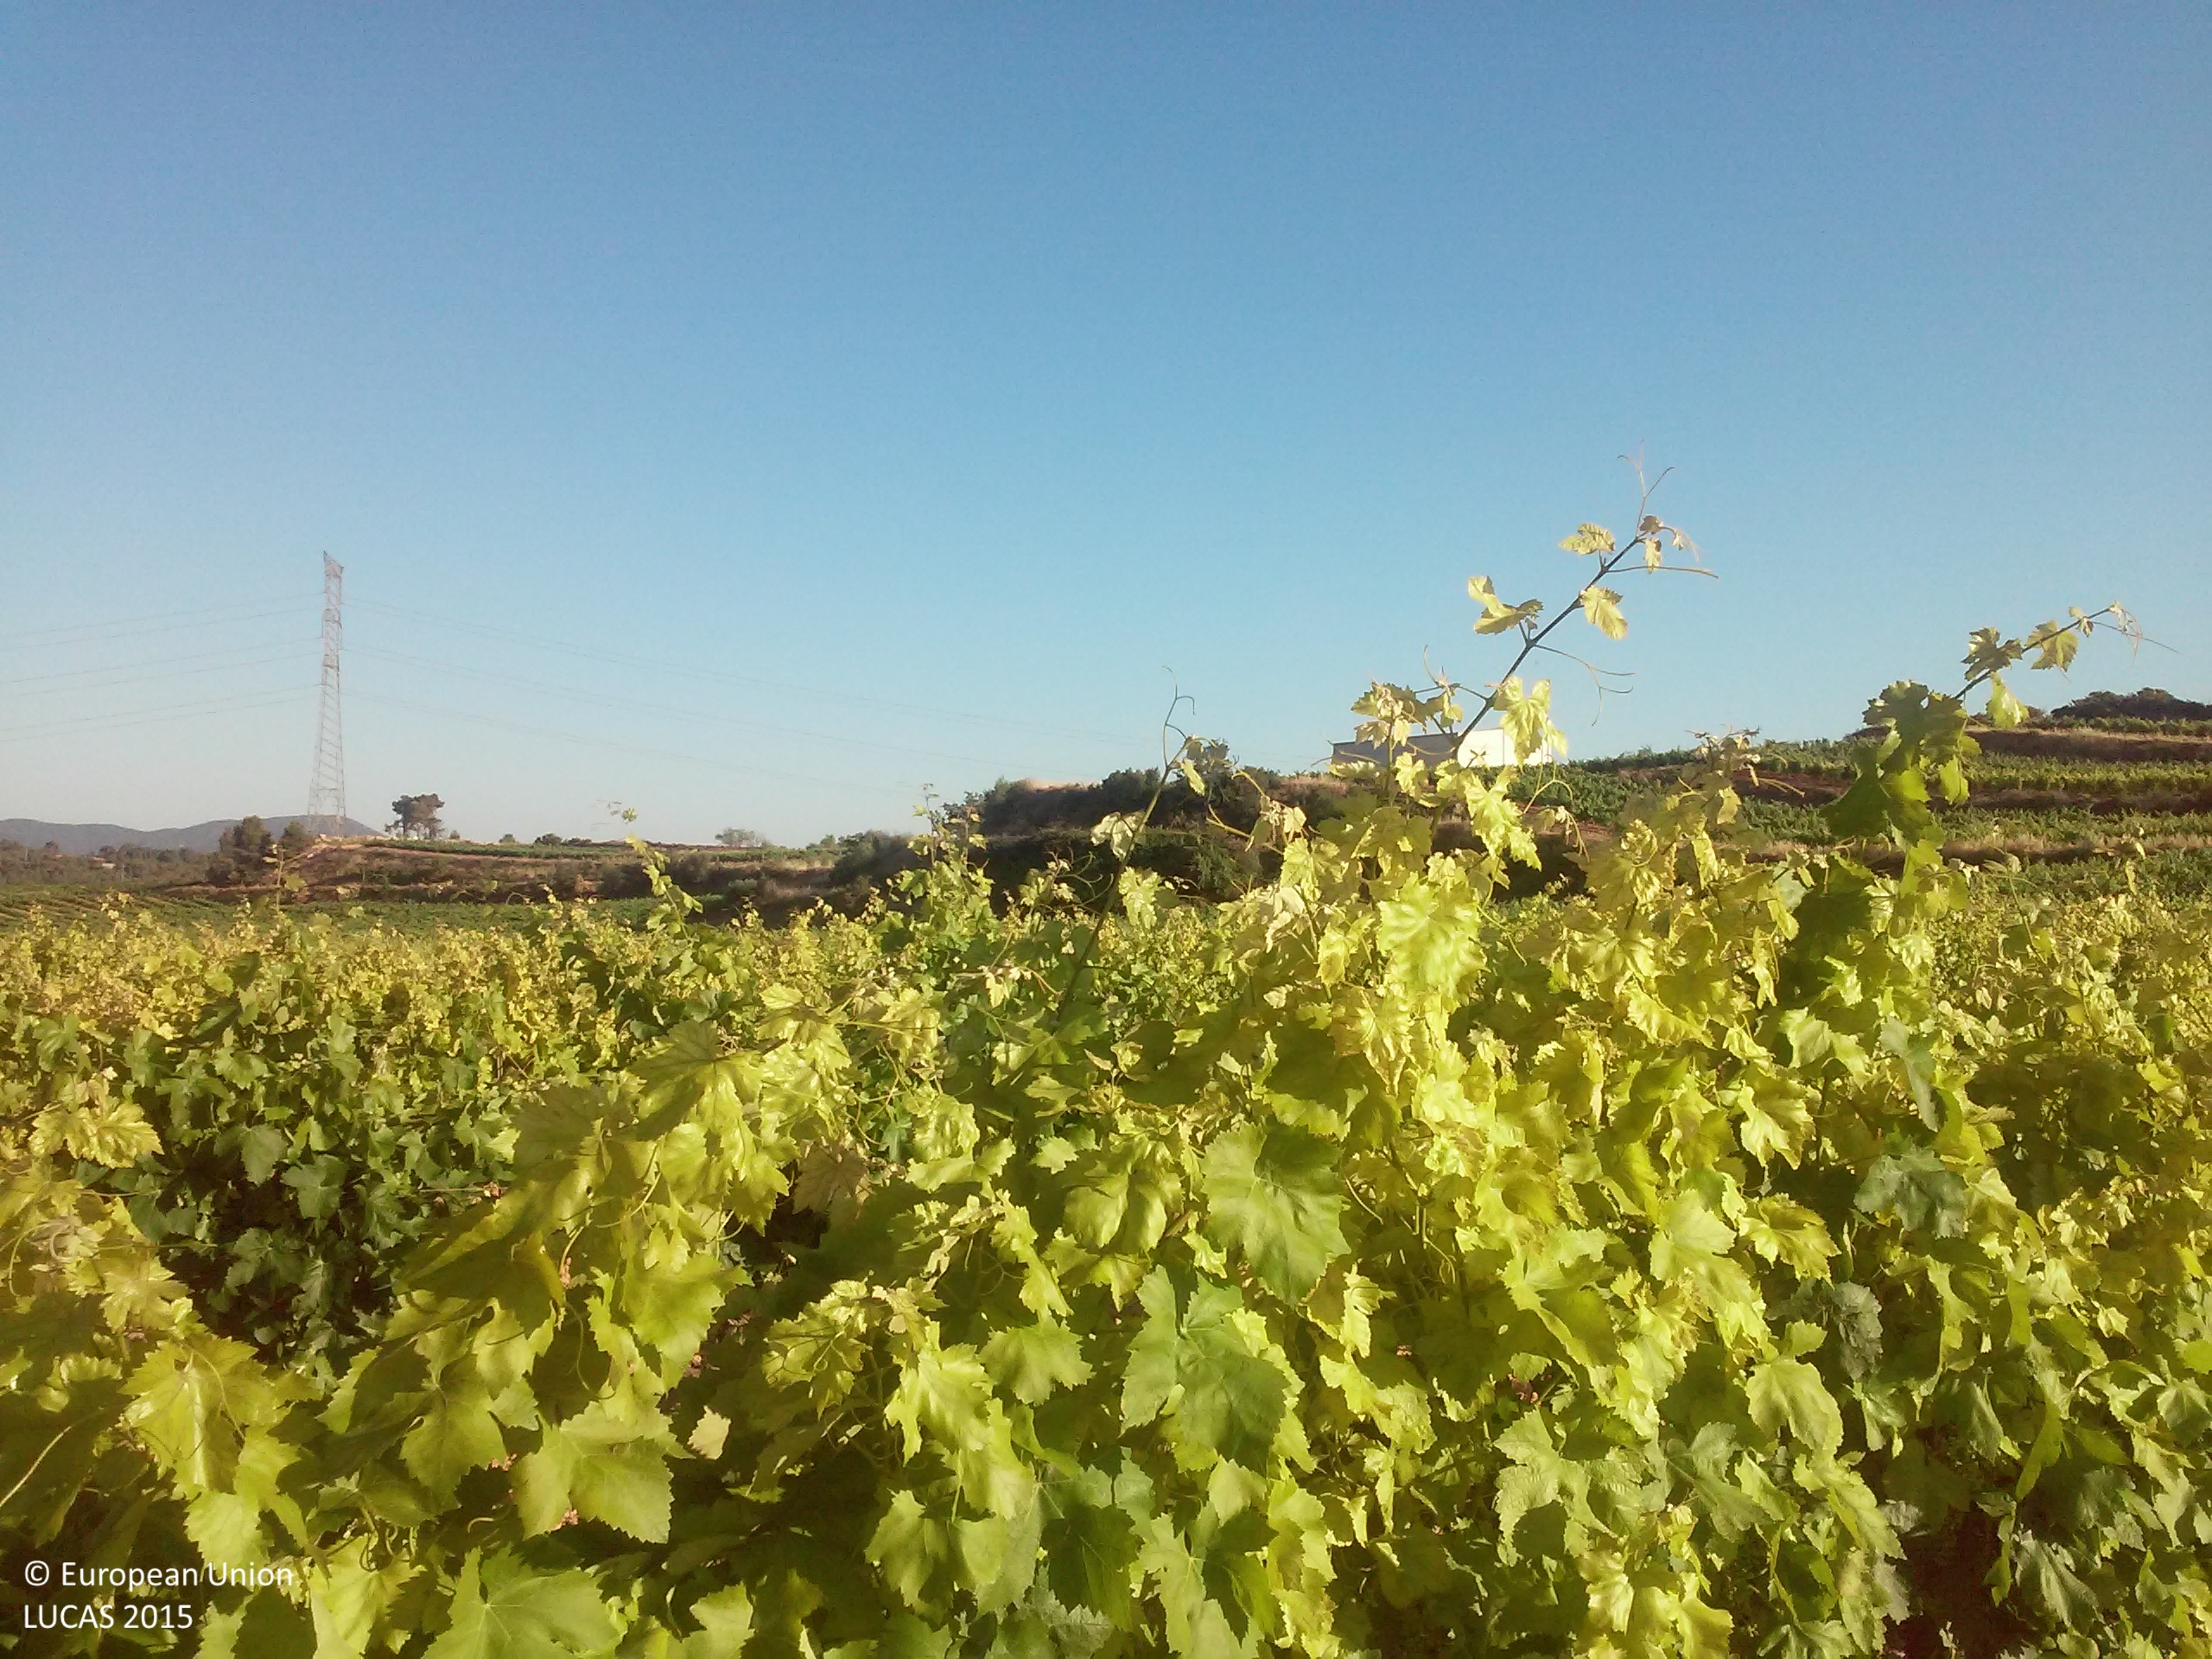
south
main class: Cropland
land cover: Vineyards
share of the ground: 10 - 25 %
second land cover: Other bare soil
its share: > 75 %
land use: Agriculture (excluding fallow land and kitchen gardens)
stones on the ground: 10 - 25 %
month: June
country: ES
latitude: 41.4524
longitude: 1.1927
